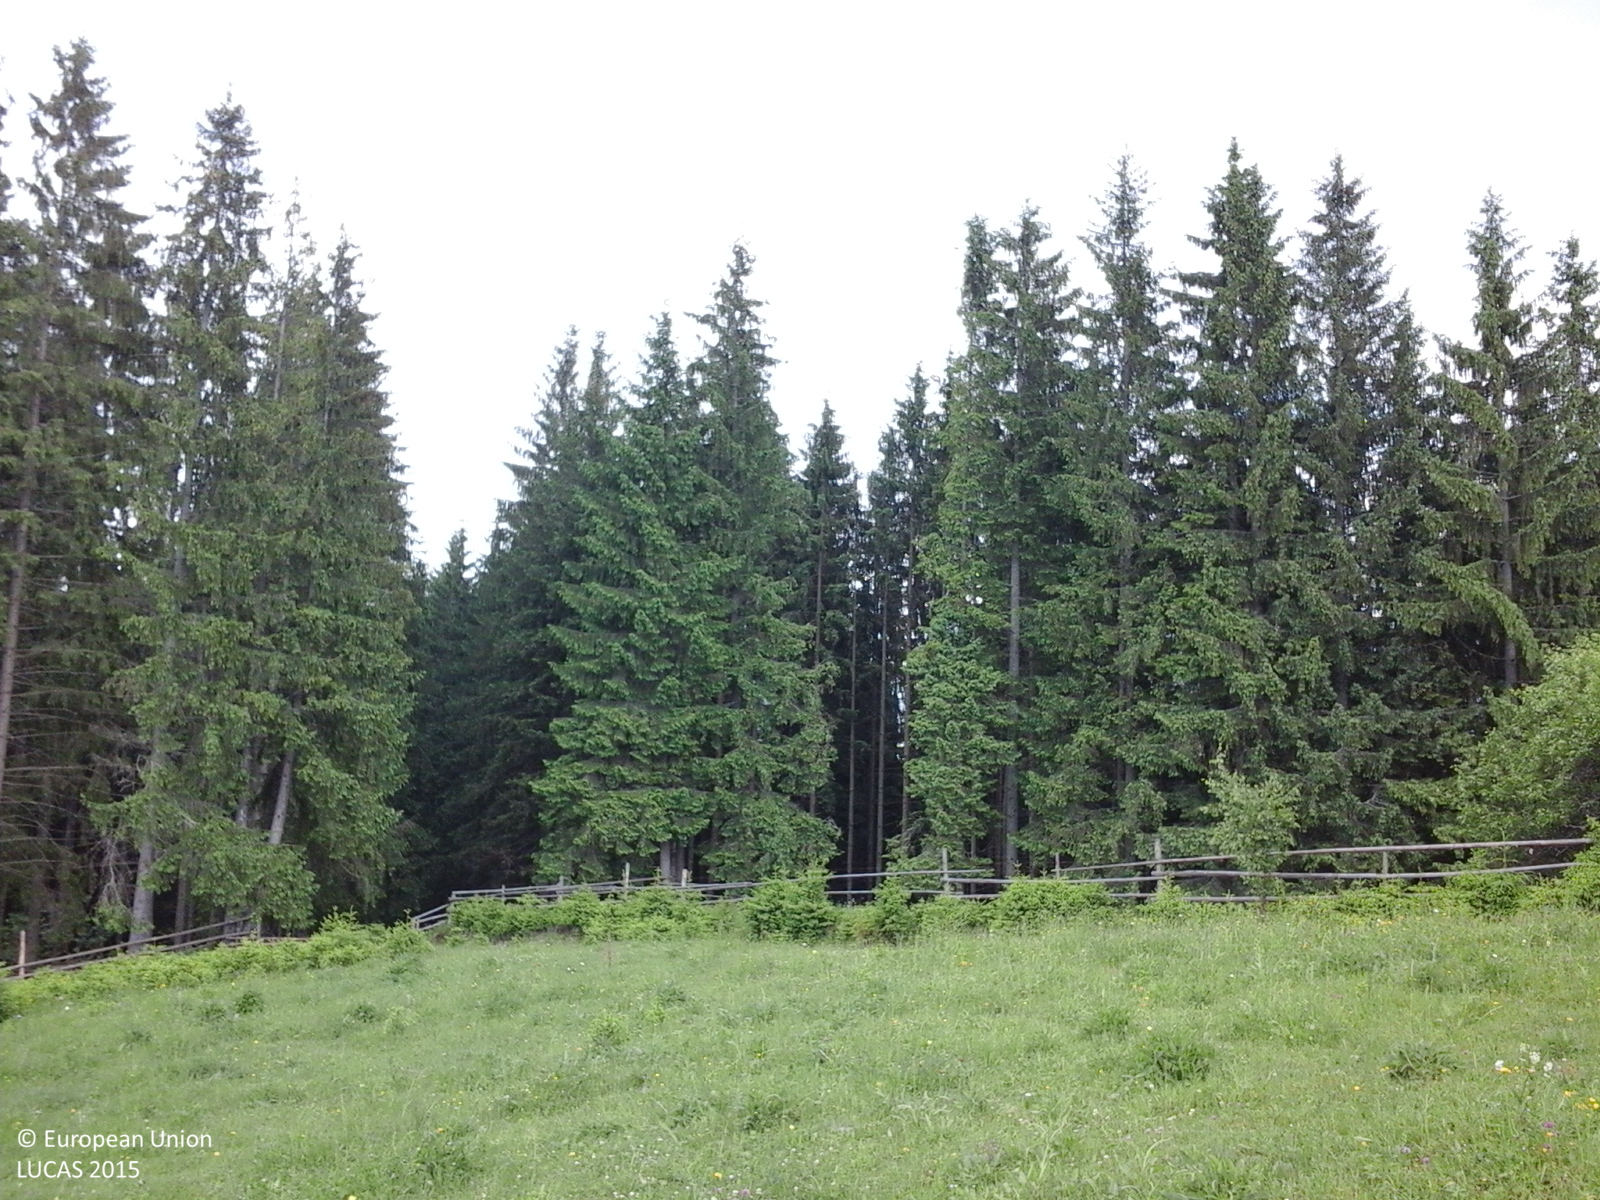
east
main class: Grassland
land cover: Grassland without tree/shrub cover
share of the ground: > 75 %
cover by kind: herbaceous plants 100 %
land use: Agriculture (excluding fallow land and kitchen gardens)
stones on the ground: < 10 %
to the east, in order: Grassland without tree/shrub cover; Fences; Tracks; Grass margins; Spruce dominated coniferous woodland
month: June
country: RO
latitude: 47.8497
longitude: 25.2539
